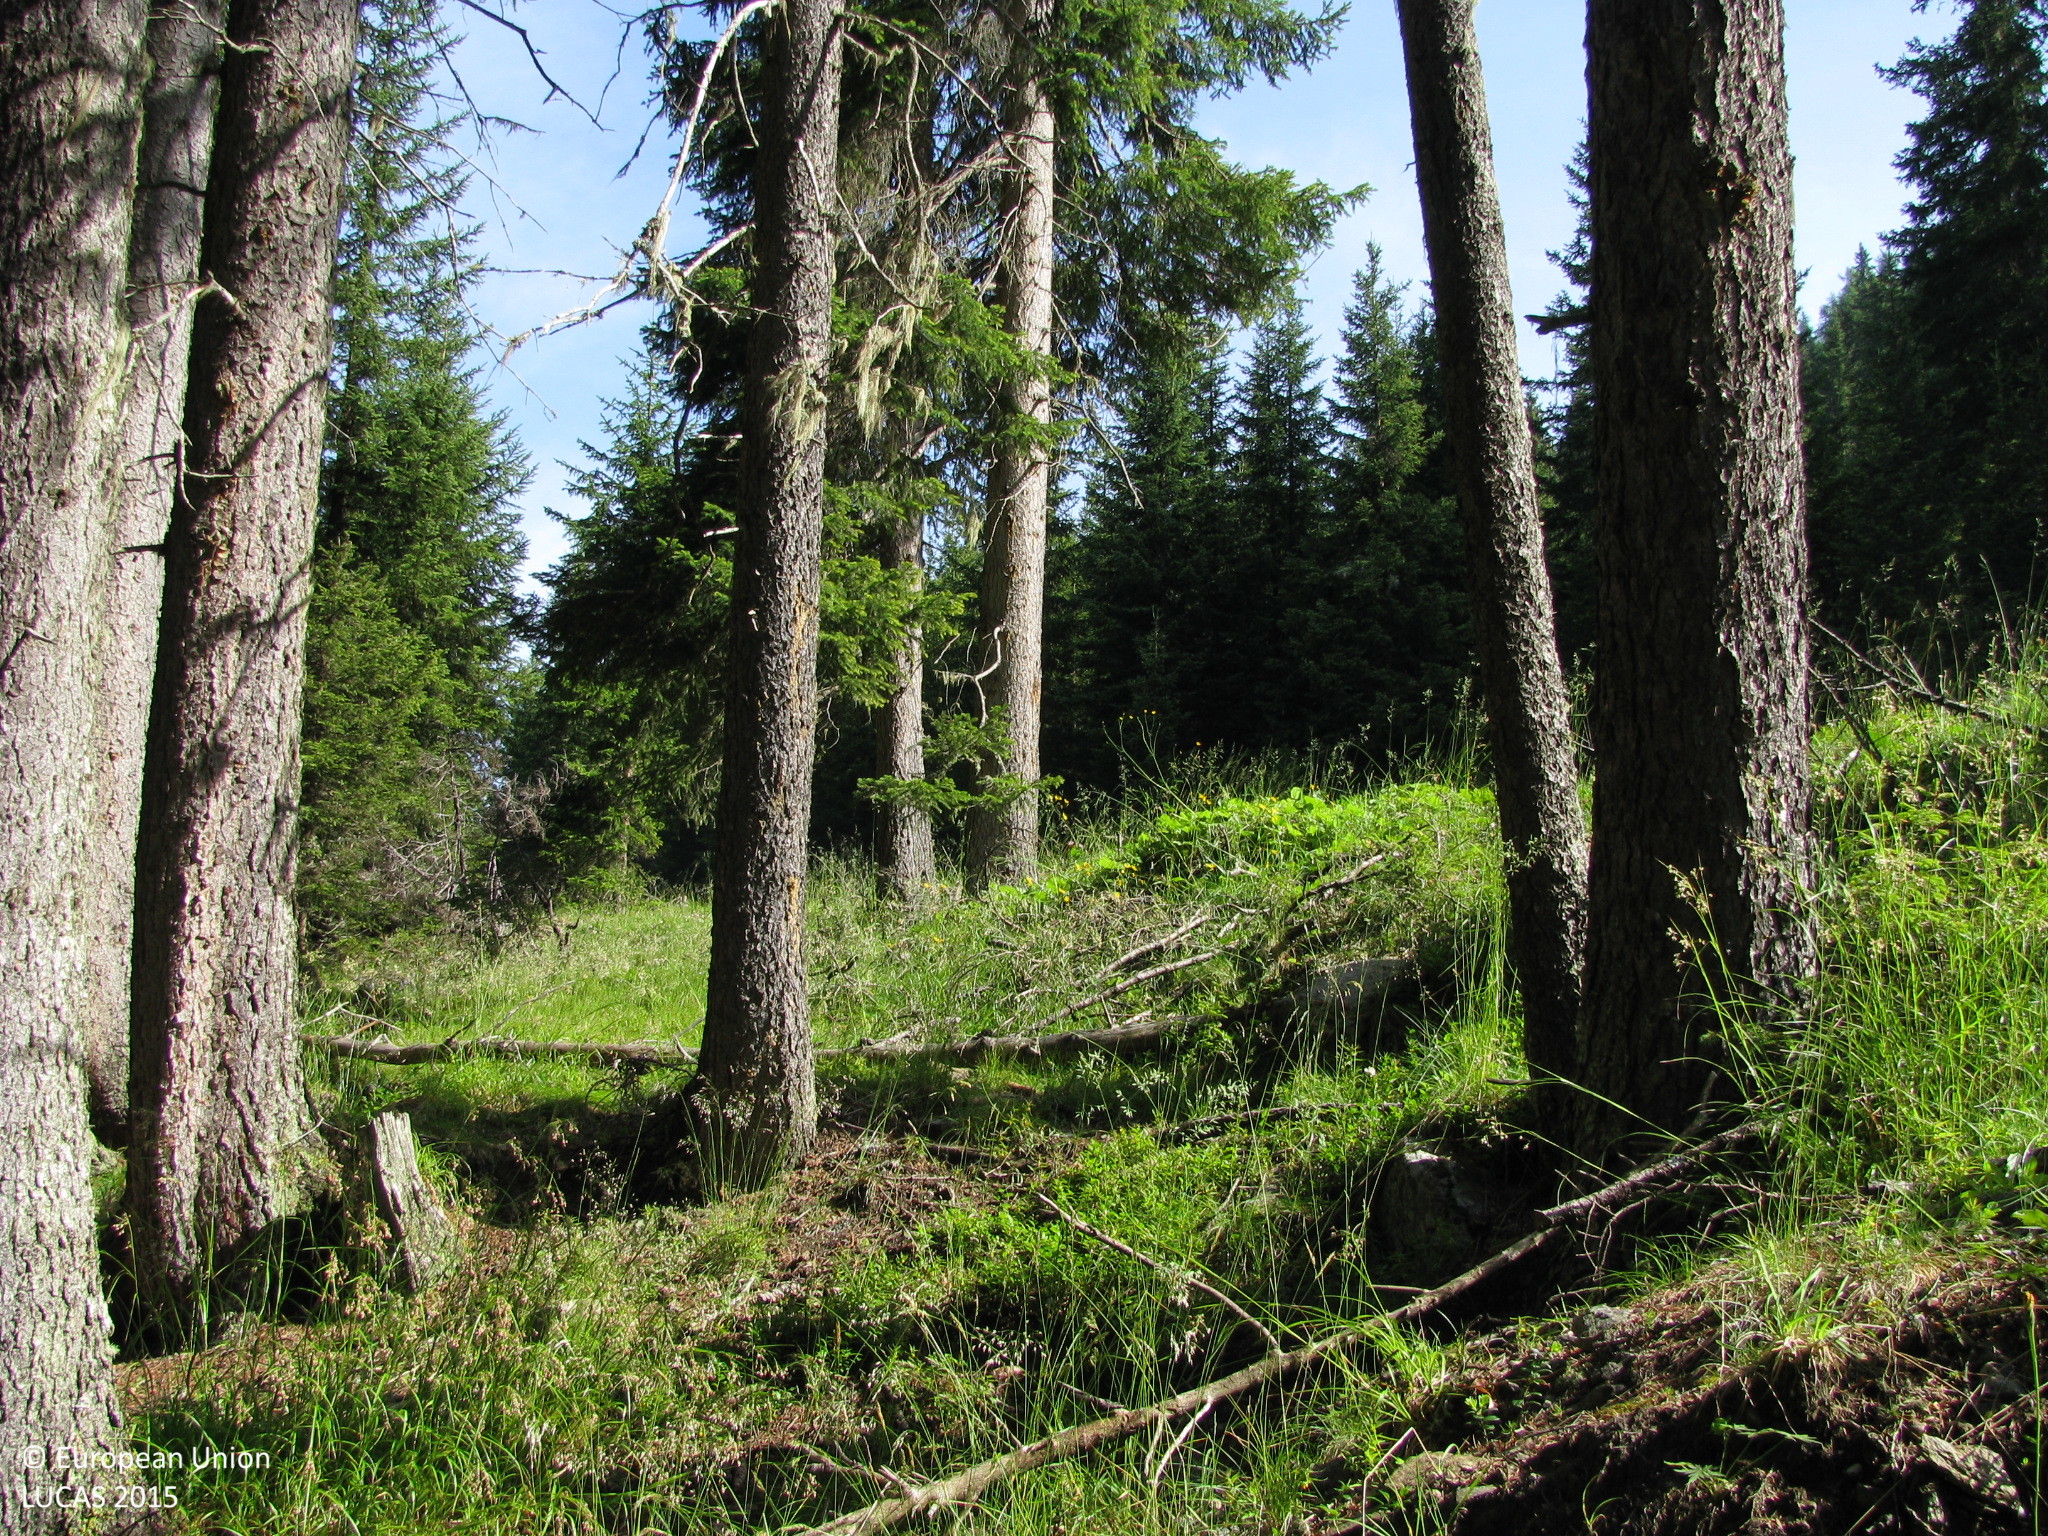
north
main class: Woodland
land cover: Spruce dominated coniferous woodland
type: alpine coniferous forest
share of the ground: > 75 %
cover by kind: coniferous forest trees 80 %, herbaceous plants 10 %, shrubs 5 %, lichens and mosses 5 %
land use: Forestry
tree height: > 5 m
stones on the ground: 25 - 50 %
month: July
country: AT
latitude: 46.8300
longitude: 12.3444
